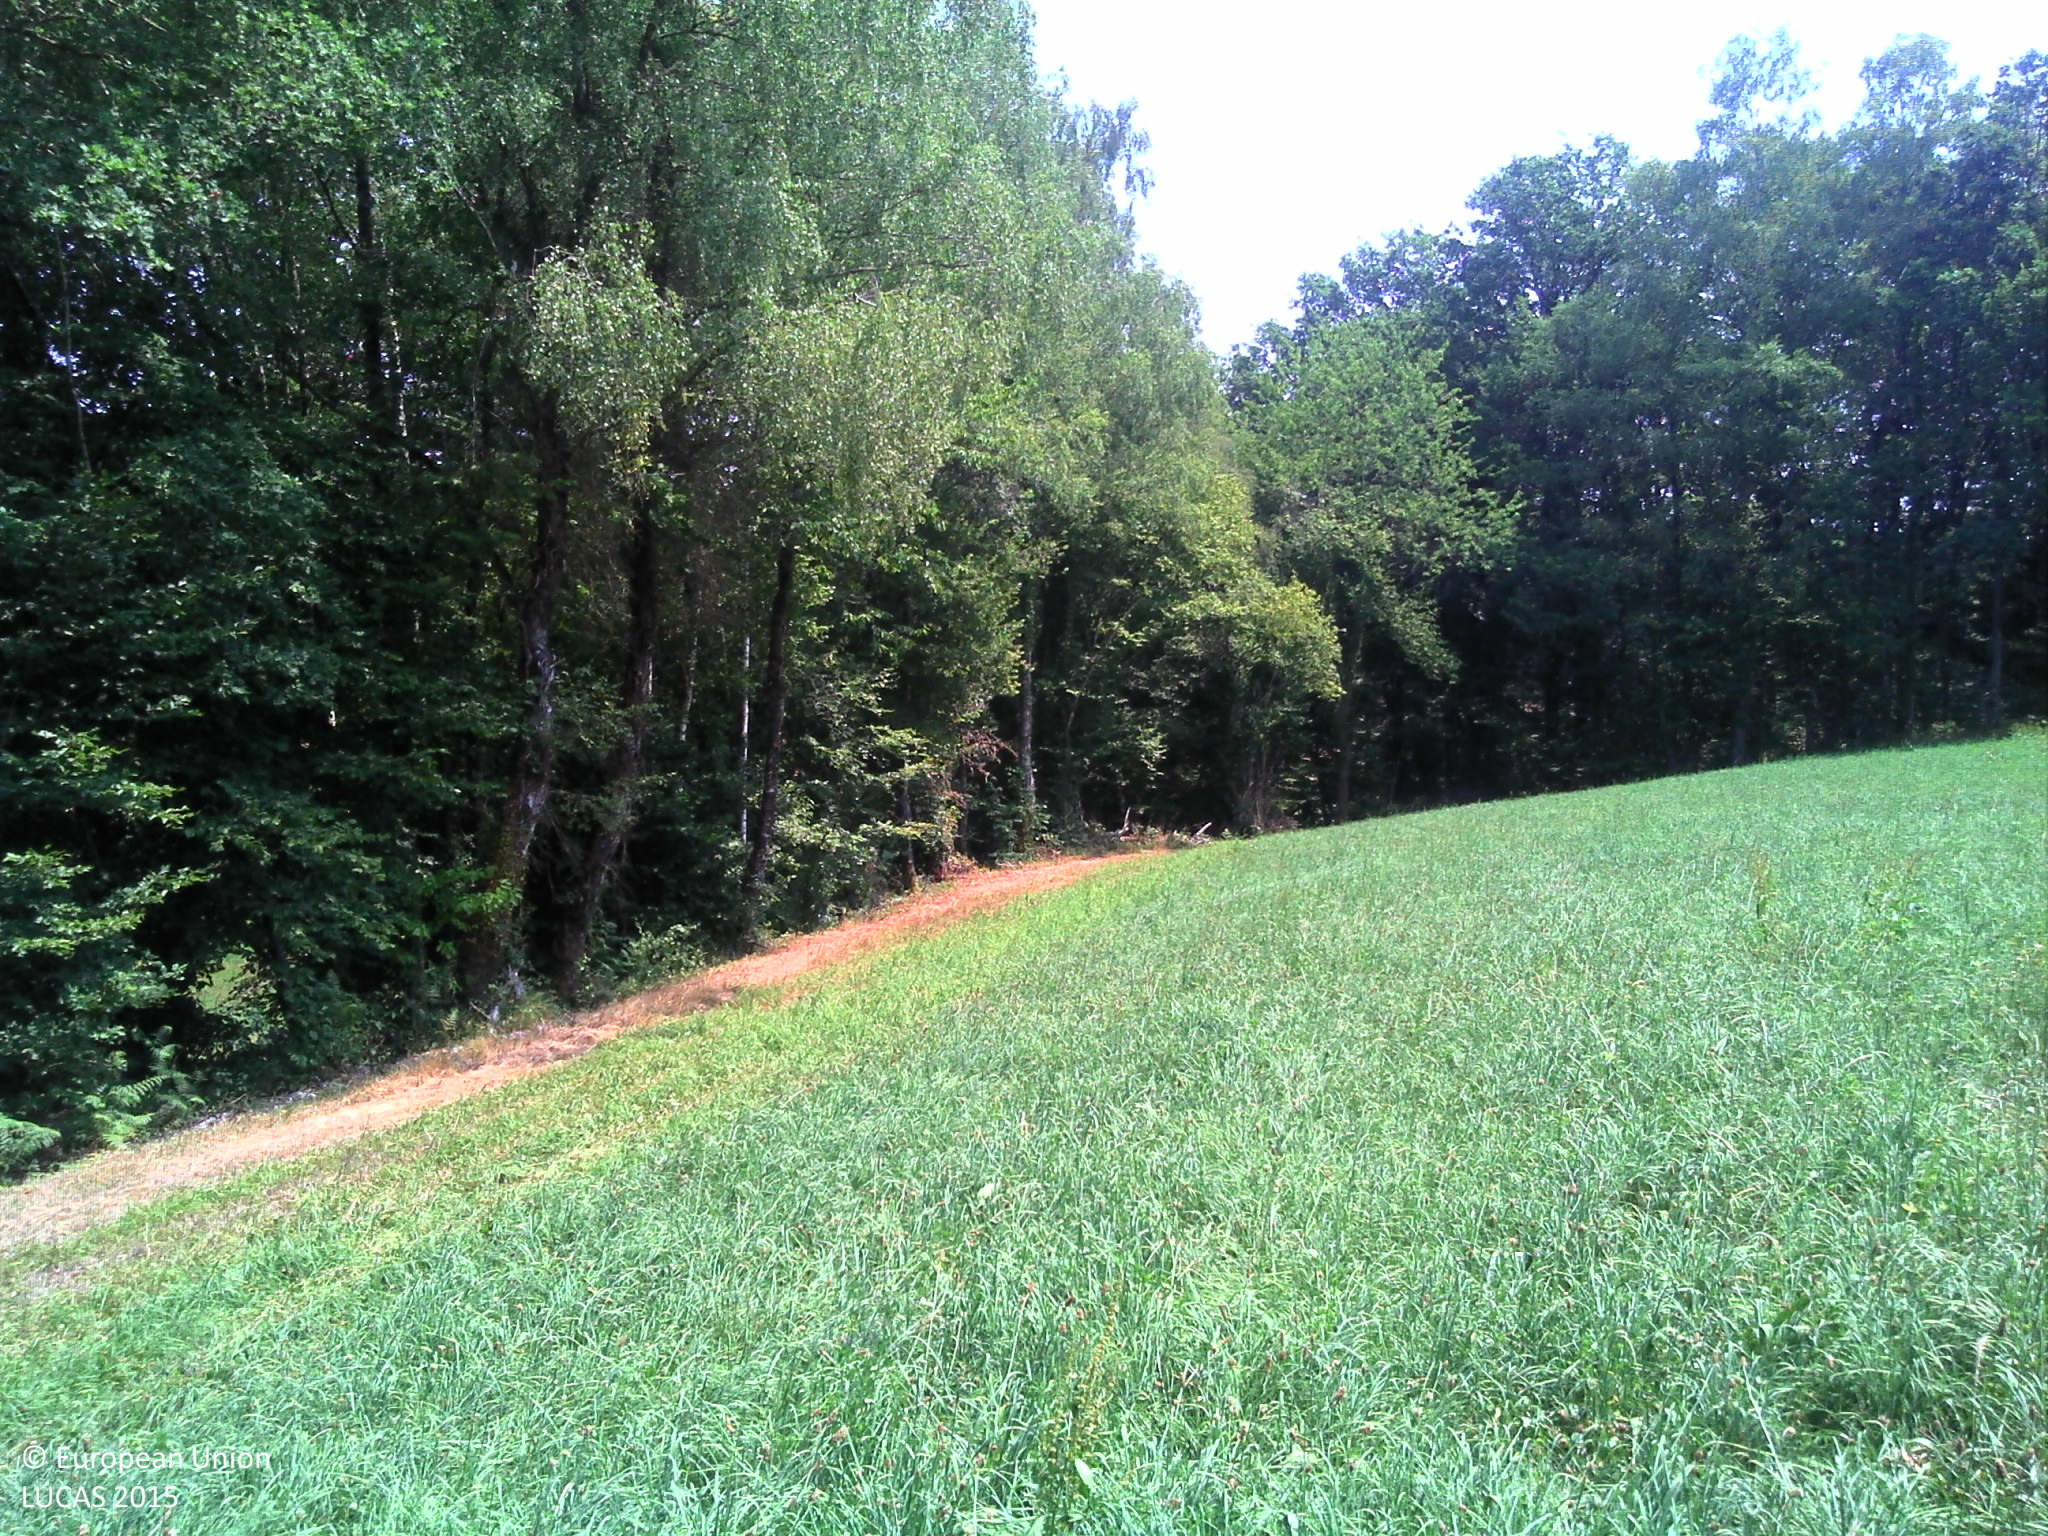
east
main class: Grassland
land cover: Grassland without tree/shrub cover
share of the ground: > 75 %
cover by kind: herbaceous plants 100 %
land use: Agriculture (excluding fallow land and kitchen gardens)
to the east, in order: Grassland without tree/shrub cover; Broadleaved woodland; Fences; Dry stone walls; Broadleaved woodland; Ditches and canals; Grassland without tree/shrub cover; Rivers and streams; Grassland without tree/shrub cover; Fences; Inland marshes; Grassland without tree/shrub cover; Fences; Grassland without tree/shrub cover
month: July
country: FR
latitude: 46.0172
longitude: 1.7913
